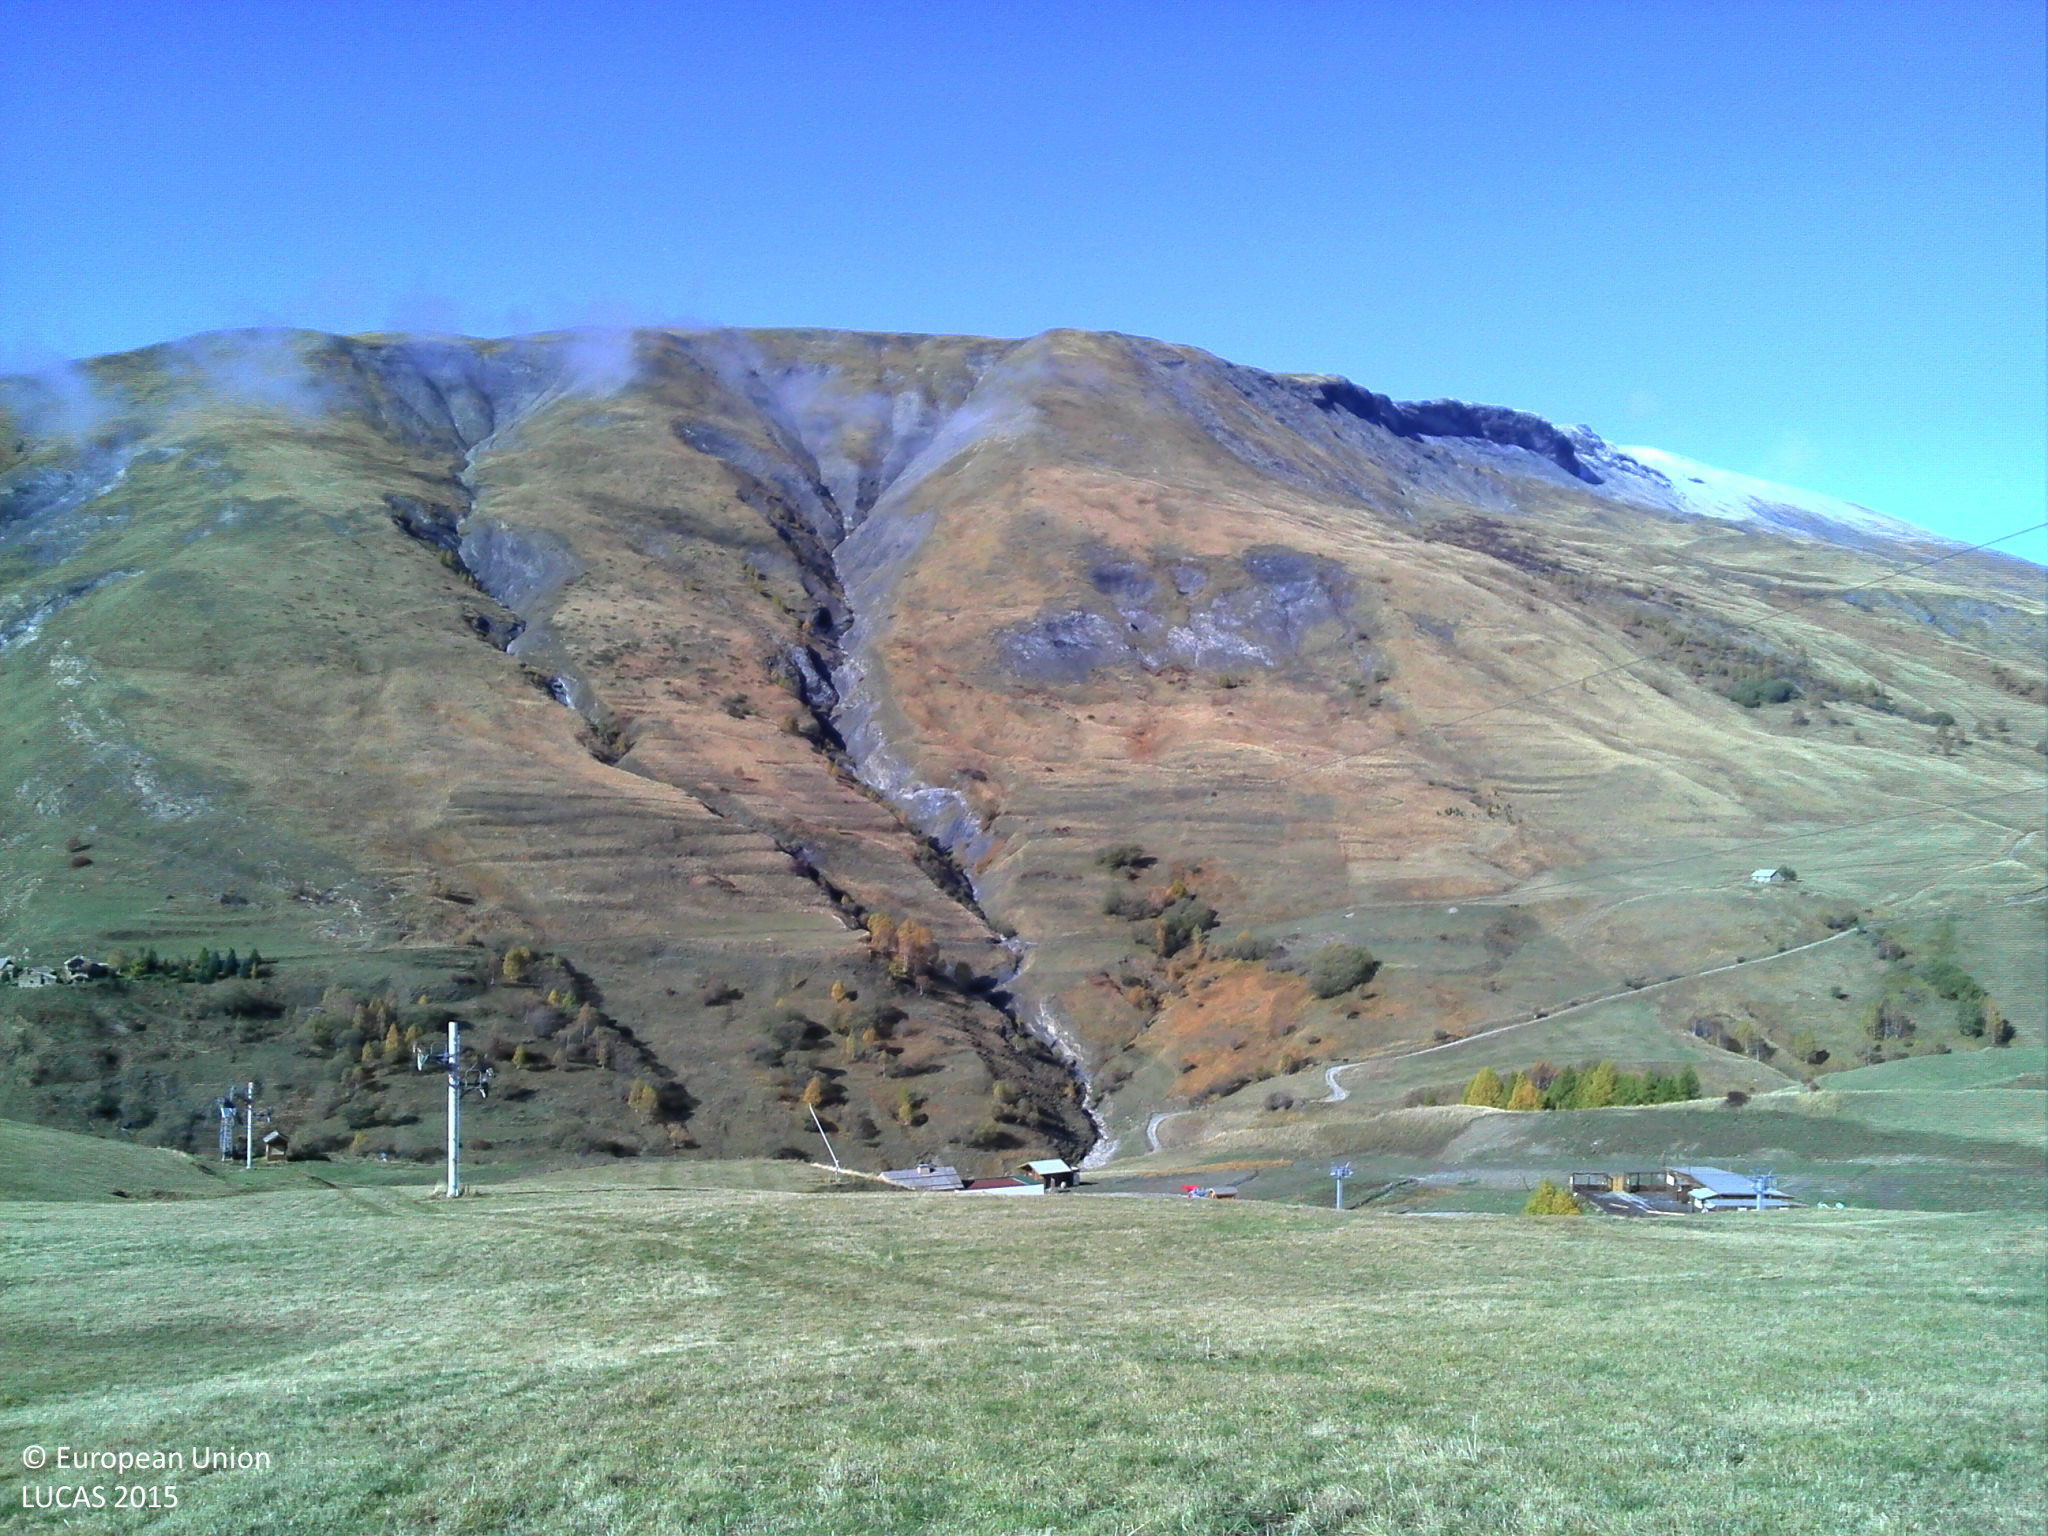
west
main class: Grassland
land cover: Grassland without tree/shrub cover
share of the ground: > 75 %
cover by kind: herbaceous plants 95 %, unconsolidated bare surface 5 %
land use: Agriculture (excluding fallow land and kitchen gardens)
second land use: Sport
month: October
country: FR
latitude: 45.0602
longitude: 6.2846
